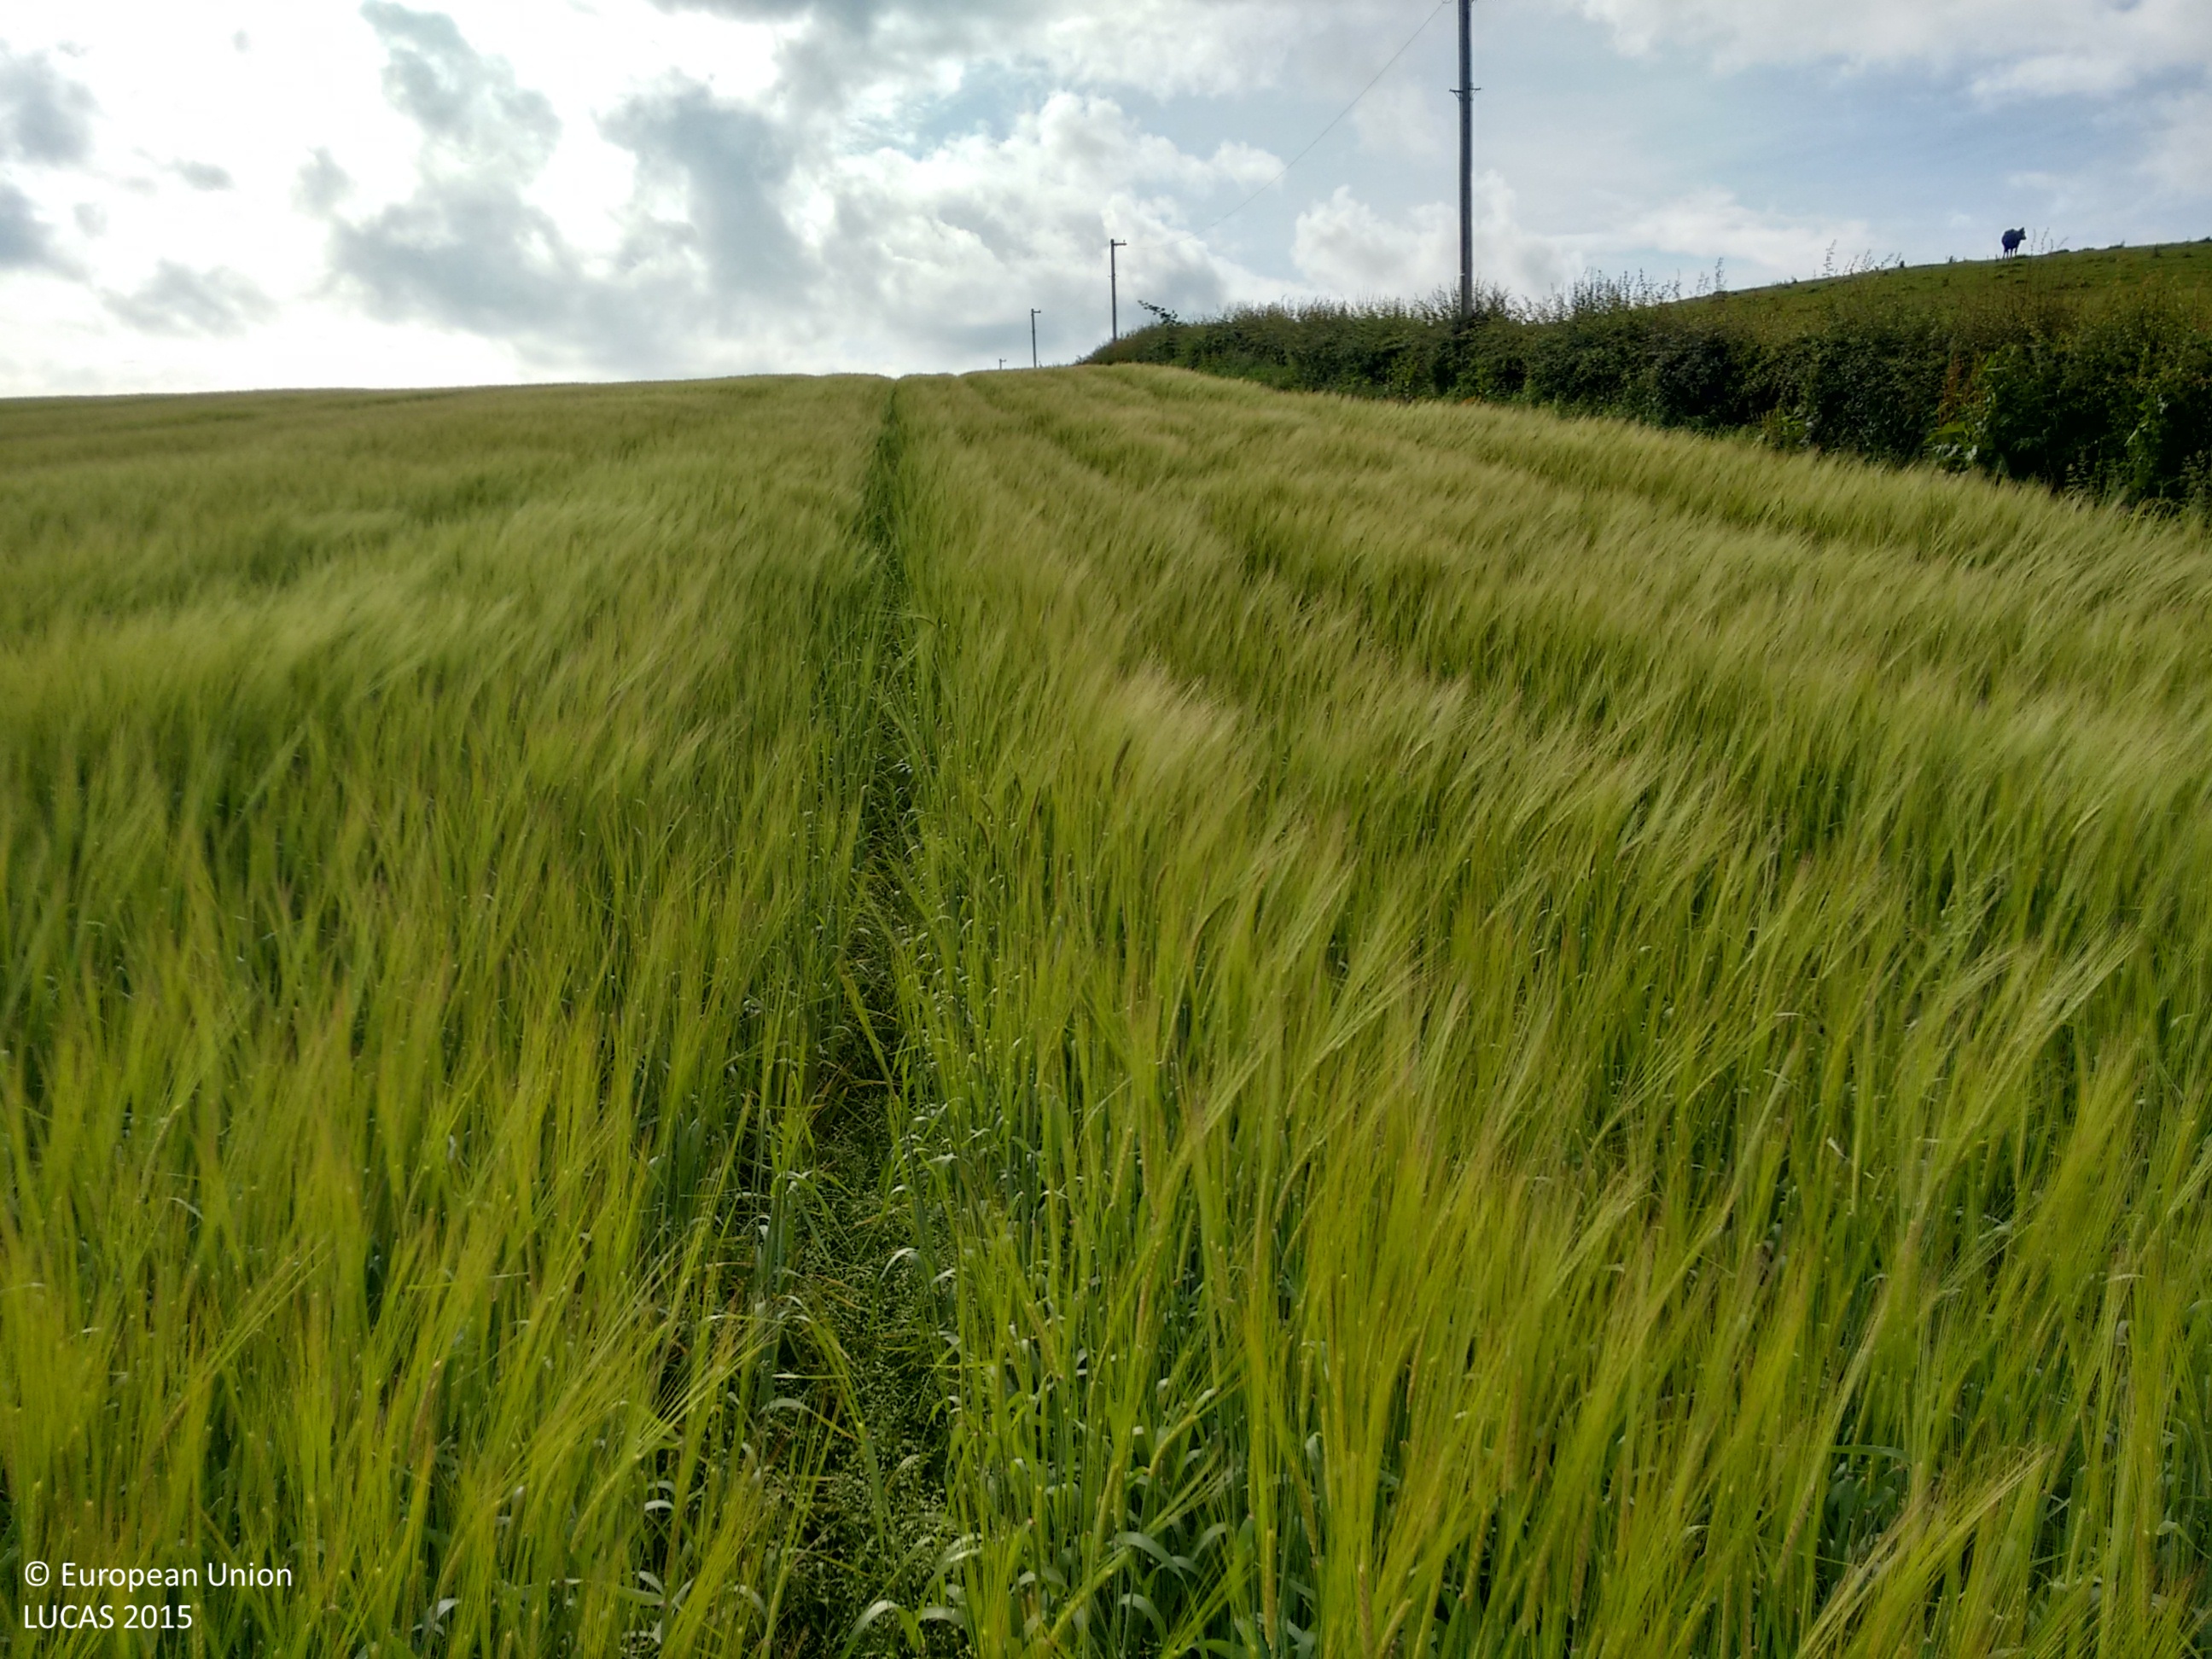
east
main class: Cropland
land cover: Barley
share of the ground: > 75 %
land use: Agriculture (excluding fallow land and kitchen gardens)
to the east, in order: Barley; Grass margins; Paved roads, cycling and walking lanes; Grass margins; Fences; Grassland without tree/shrub cover; Fences; Grassland without tree/shrub cover; Fences; Broadleaved woodland; Rivers and streams; Broadleaved woodland; Permanent crops (only in case pi)
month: July
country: GB
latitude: 55.8534
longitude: -5.1130
